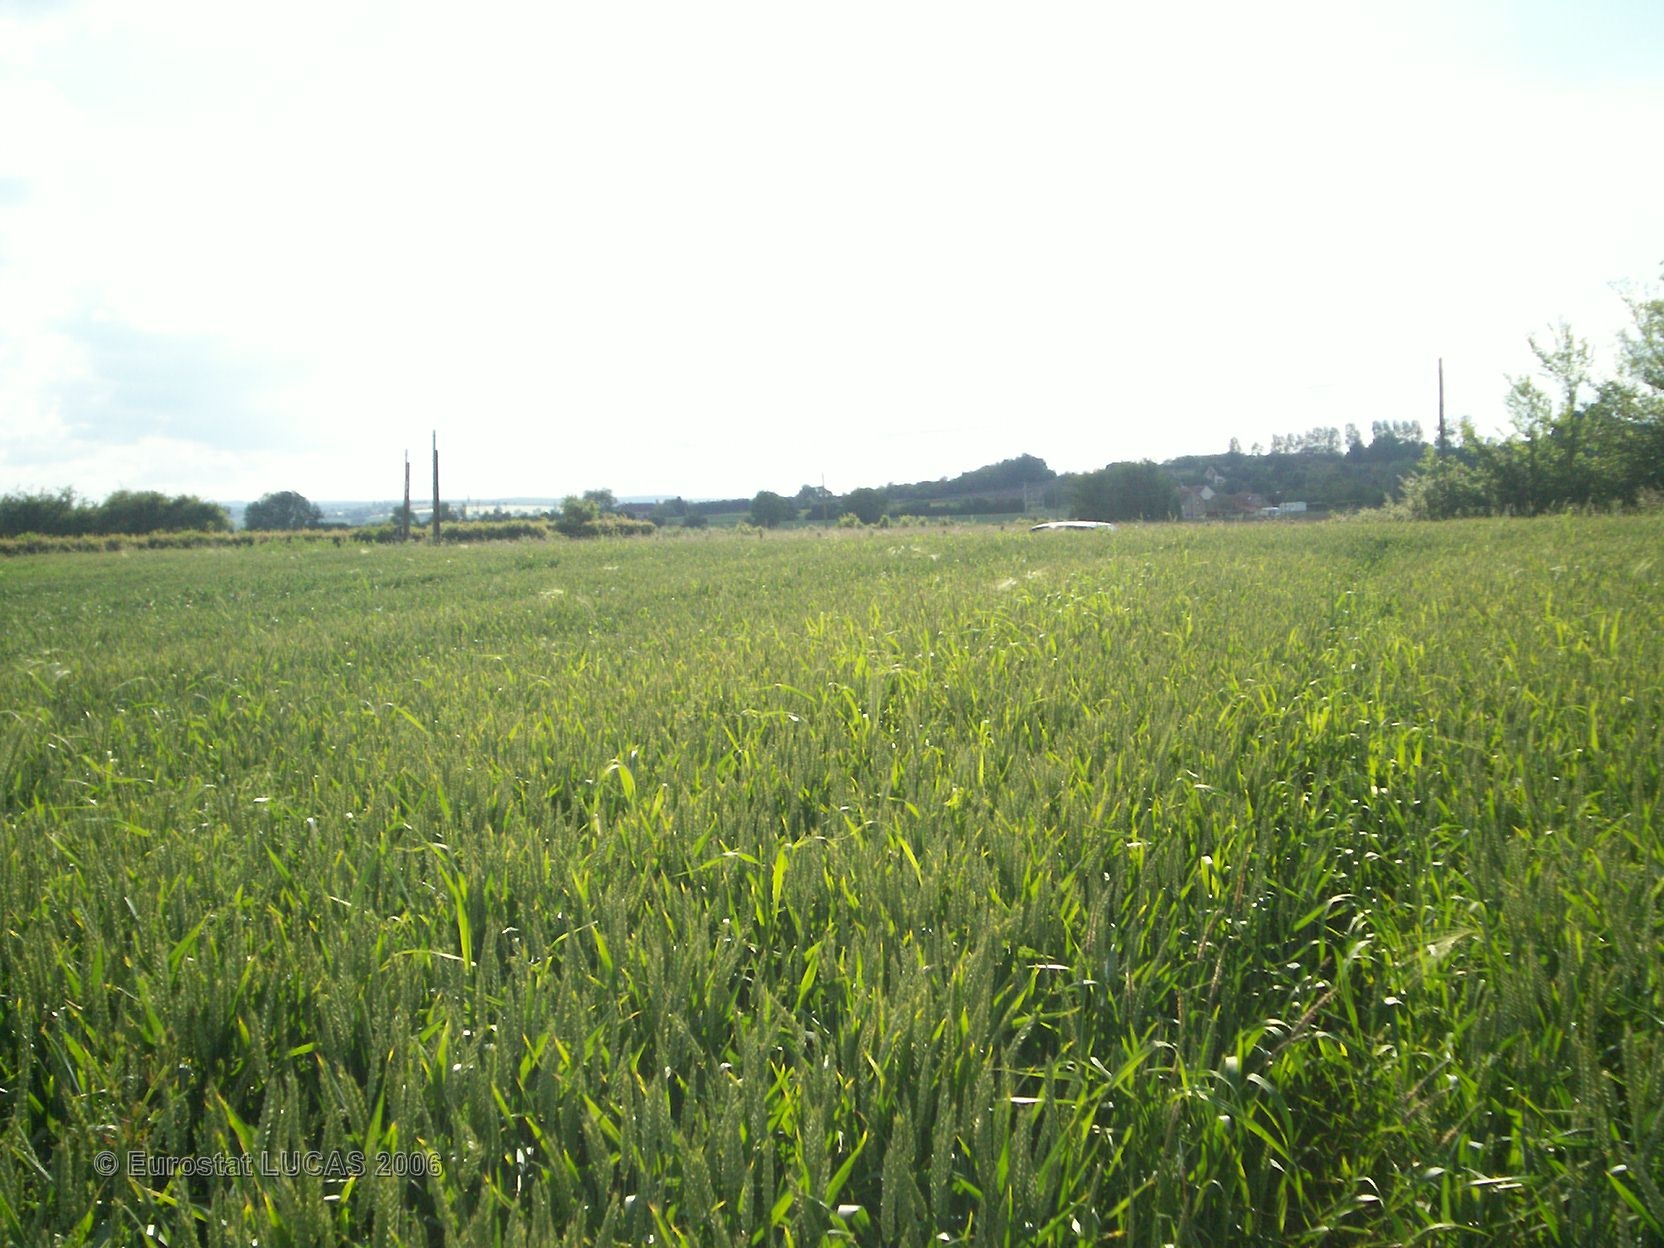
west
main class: Cropland
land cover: Common wheat
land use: Agriculture (excluding fallow land and kitchen gardens)
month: June
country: FR
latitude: 46.2196
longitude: 3.1146
